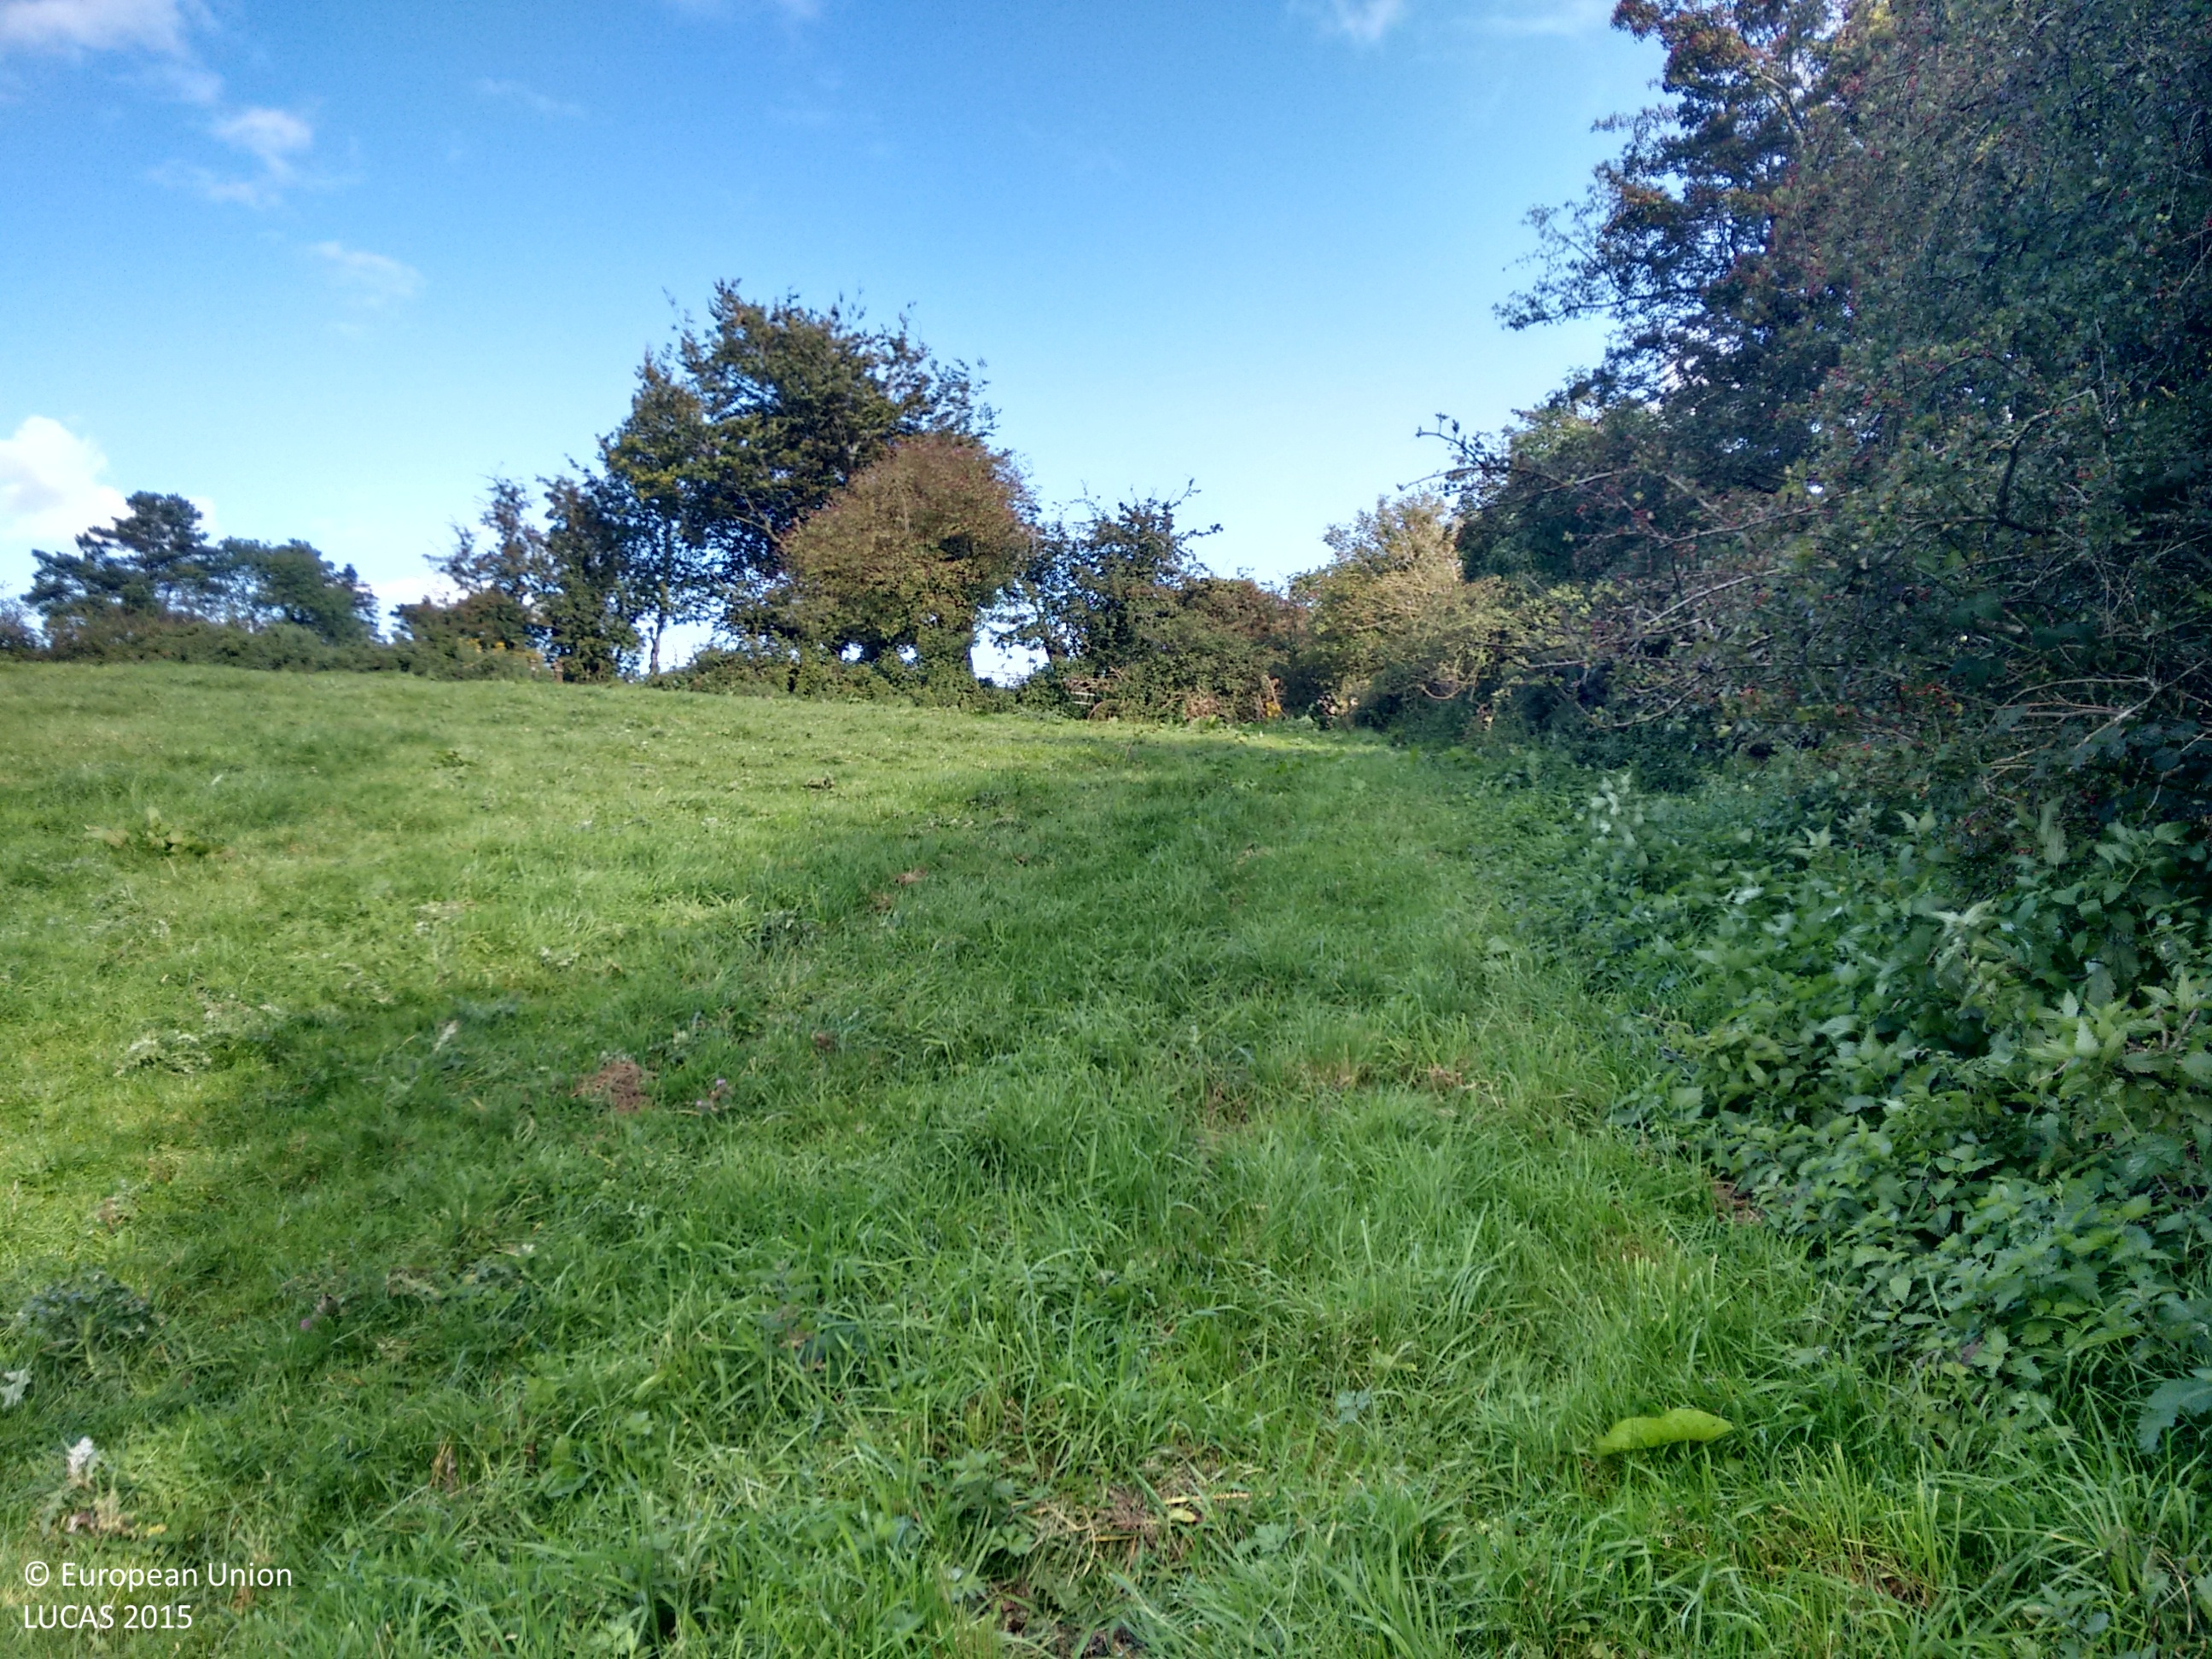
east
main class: Grassland
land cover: Grassland without tree/shrub cover
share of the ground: > 75 %
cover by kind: herbaceous plants 100 %
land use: Agriculture (excluding fallow land and kitchen gardens)
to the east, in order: Grassland without tree/shrub cover; Managed hedges; Grassland without tree/shrub cover; Managed hedges; Fences; Grassland without tree/shrub cover; Electric lines; Grassland without tree/shrub cover; Dry stone walls; Fences; Managed hedges
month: September
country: IE
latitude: 54.2168
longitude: -6.9622
